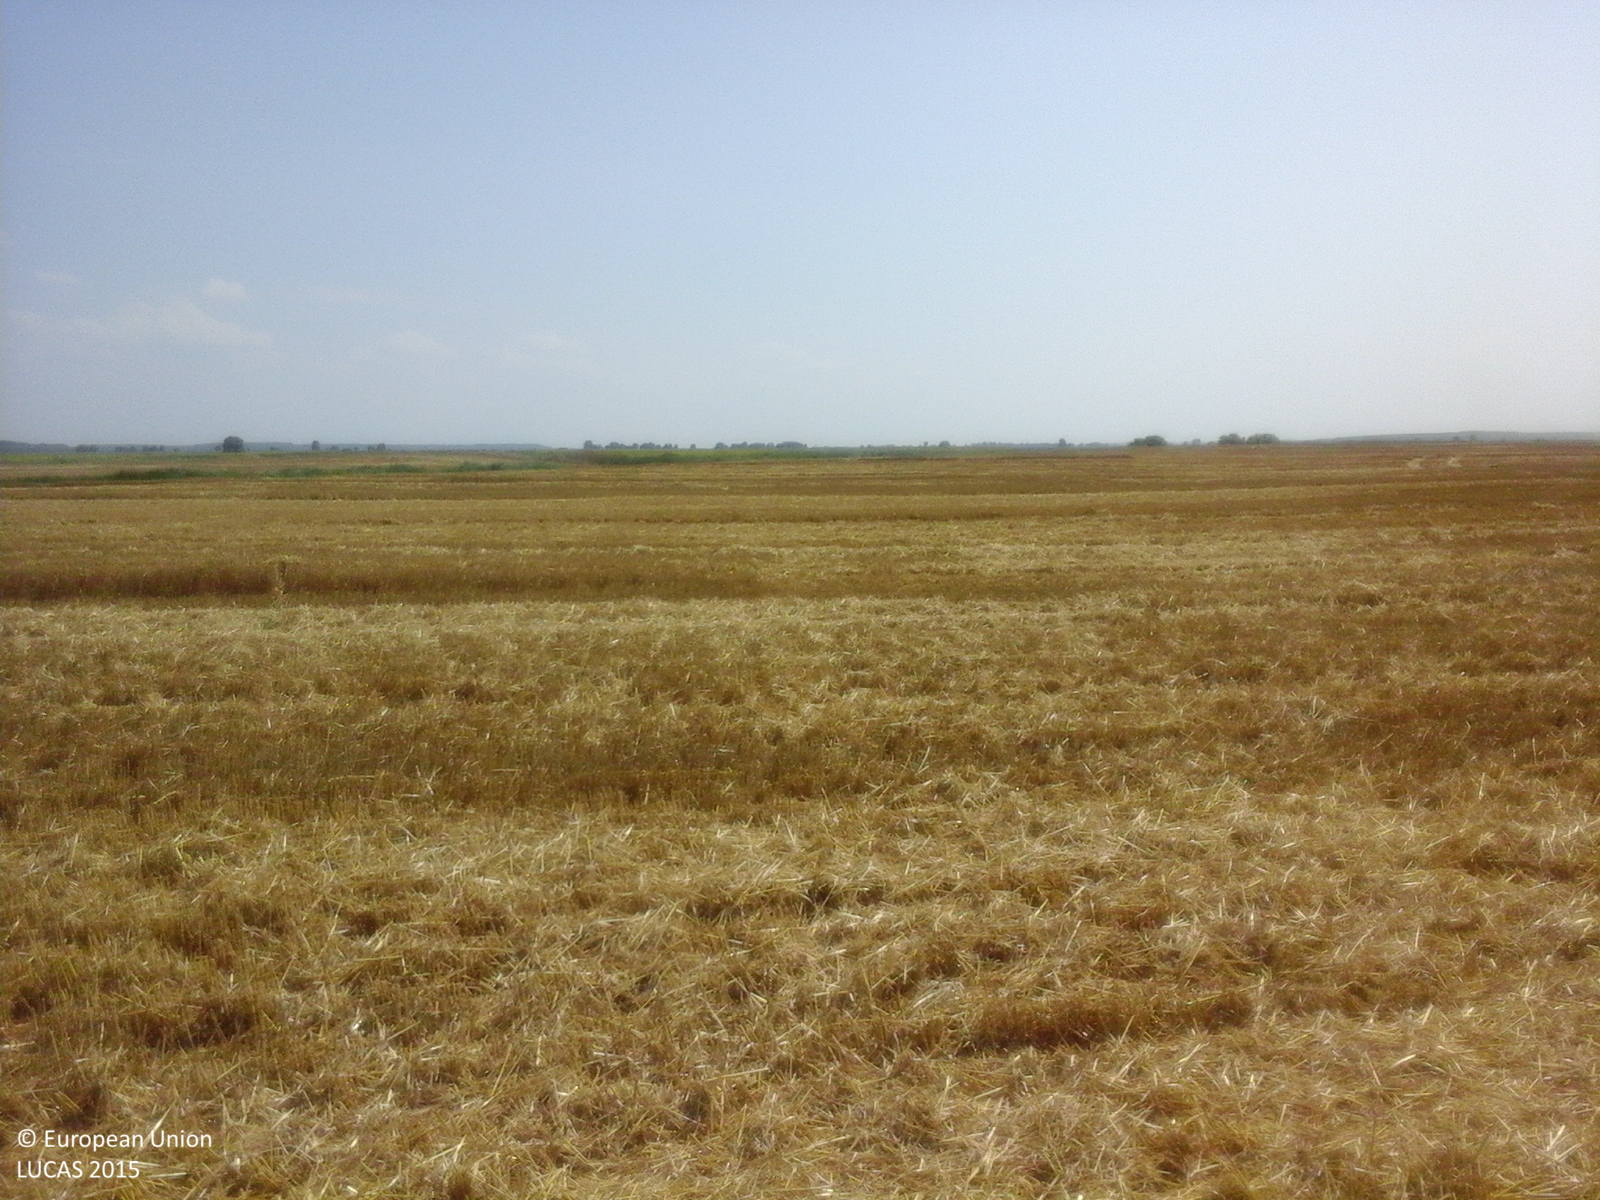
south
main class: Cropland
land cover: Common wheat
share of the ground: 50 - 75 %
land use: Agriculture (excluding fallow land and kitchen gardens)
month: July
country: RO
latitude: 44.6070
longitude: 27.9878
